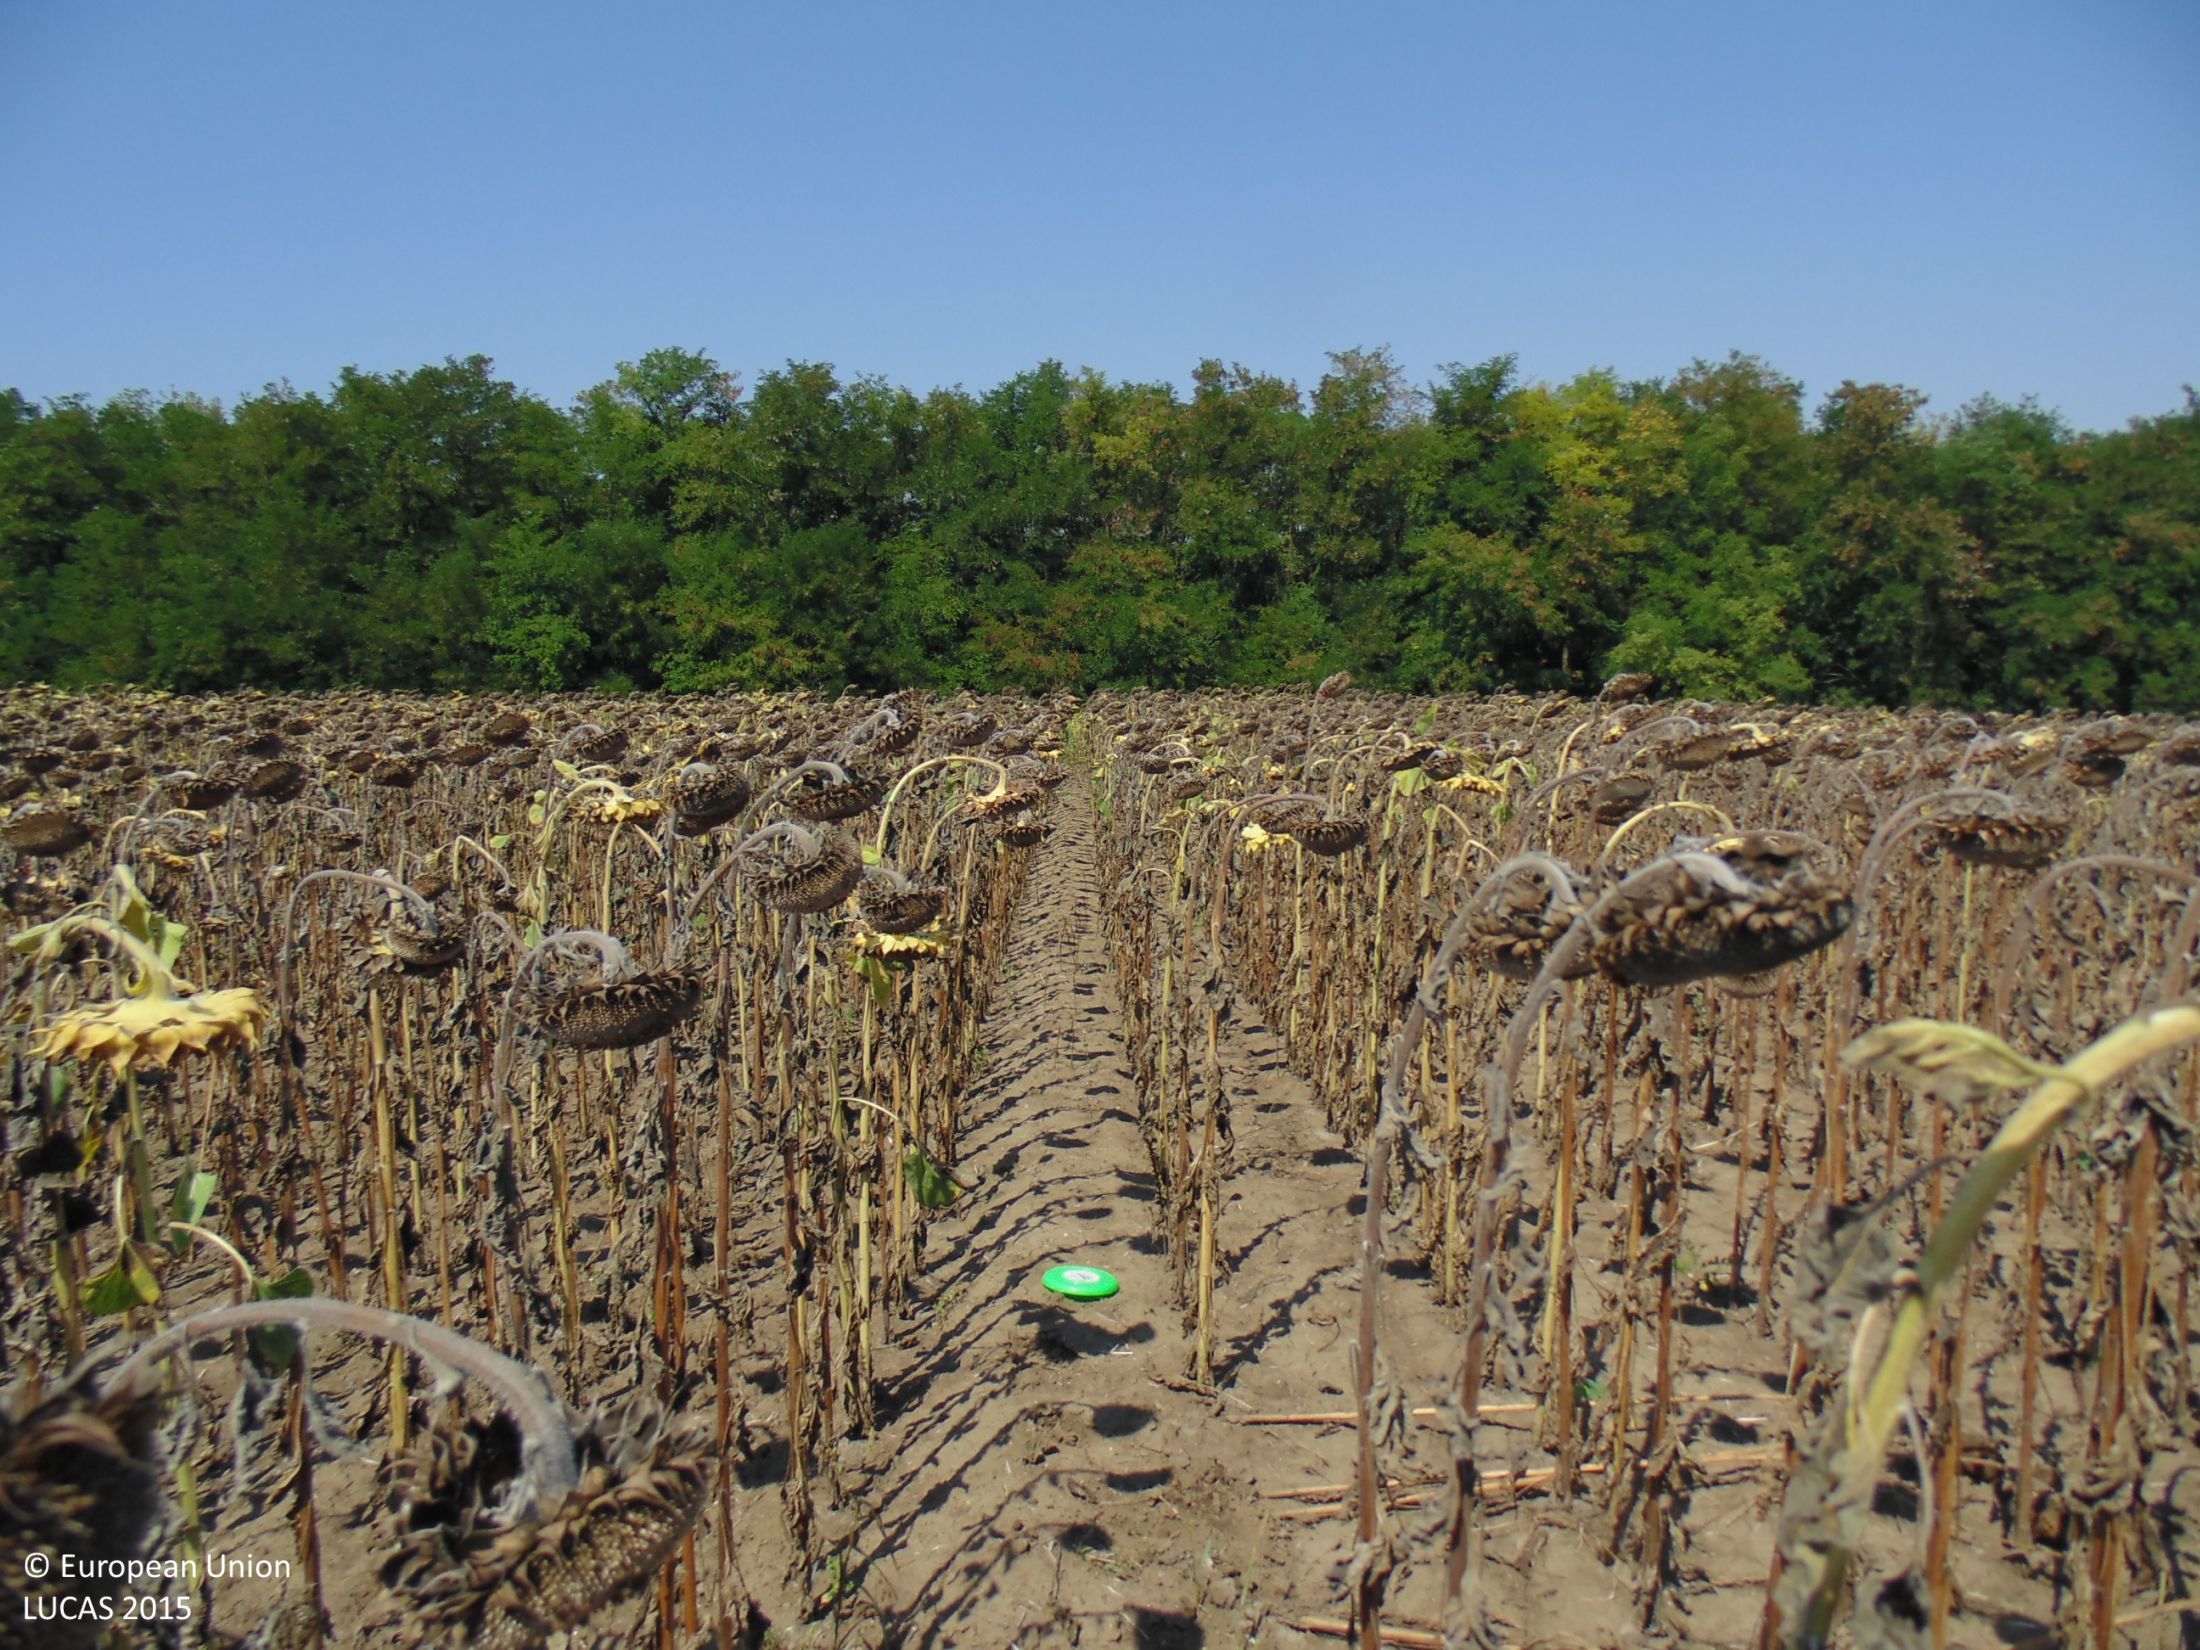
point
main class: Cropland
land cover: Sunflower
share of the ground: > 75 %
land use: Agriculture (excluding fallow land and kitchen gardens)
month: August
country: BG
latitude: 43.7239
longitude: 27.4491
